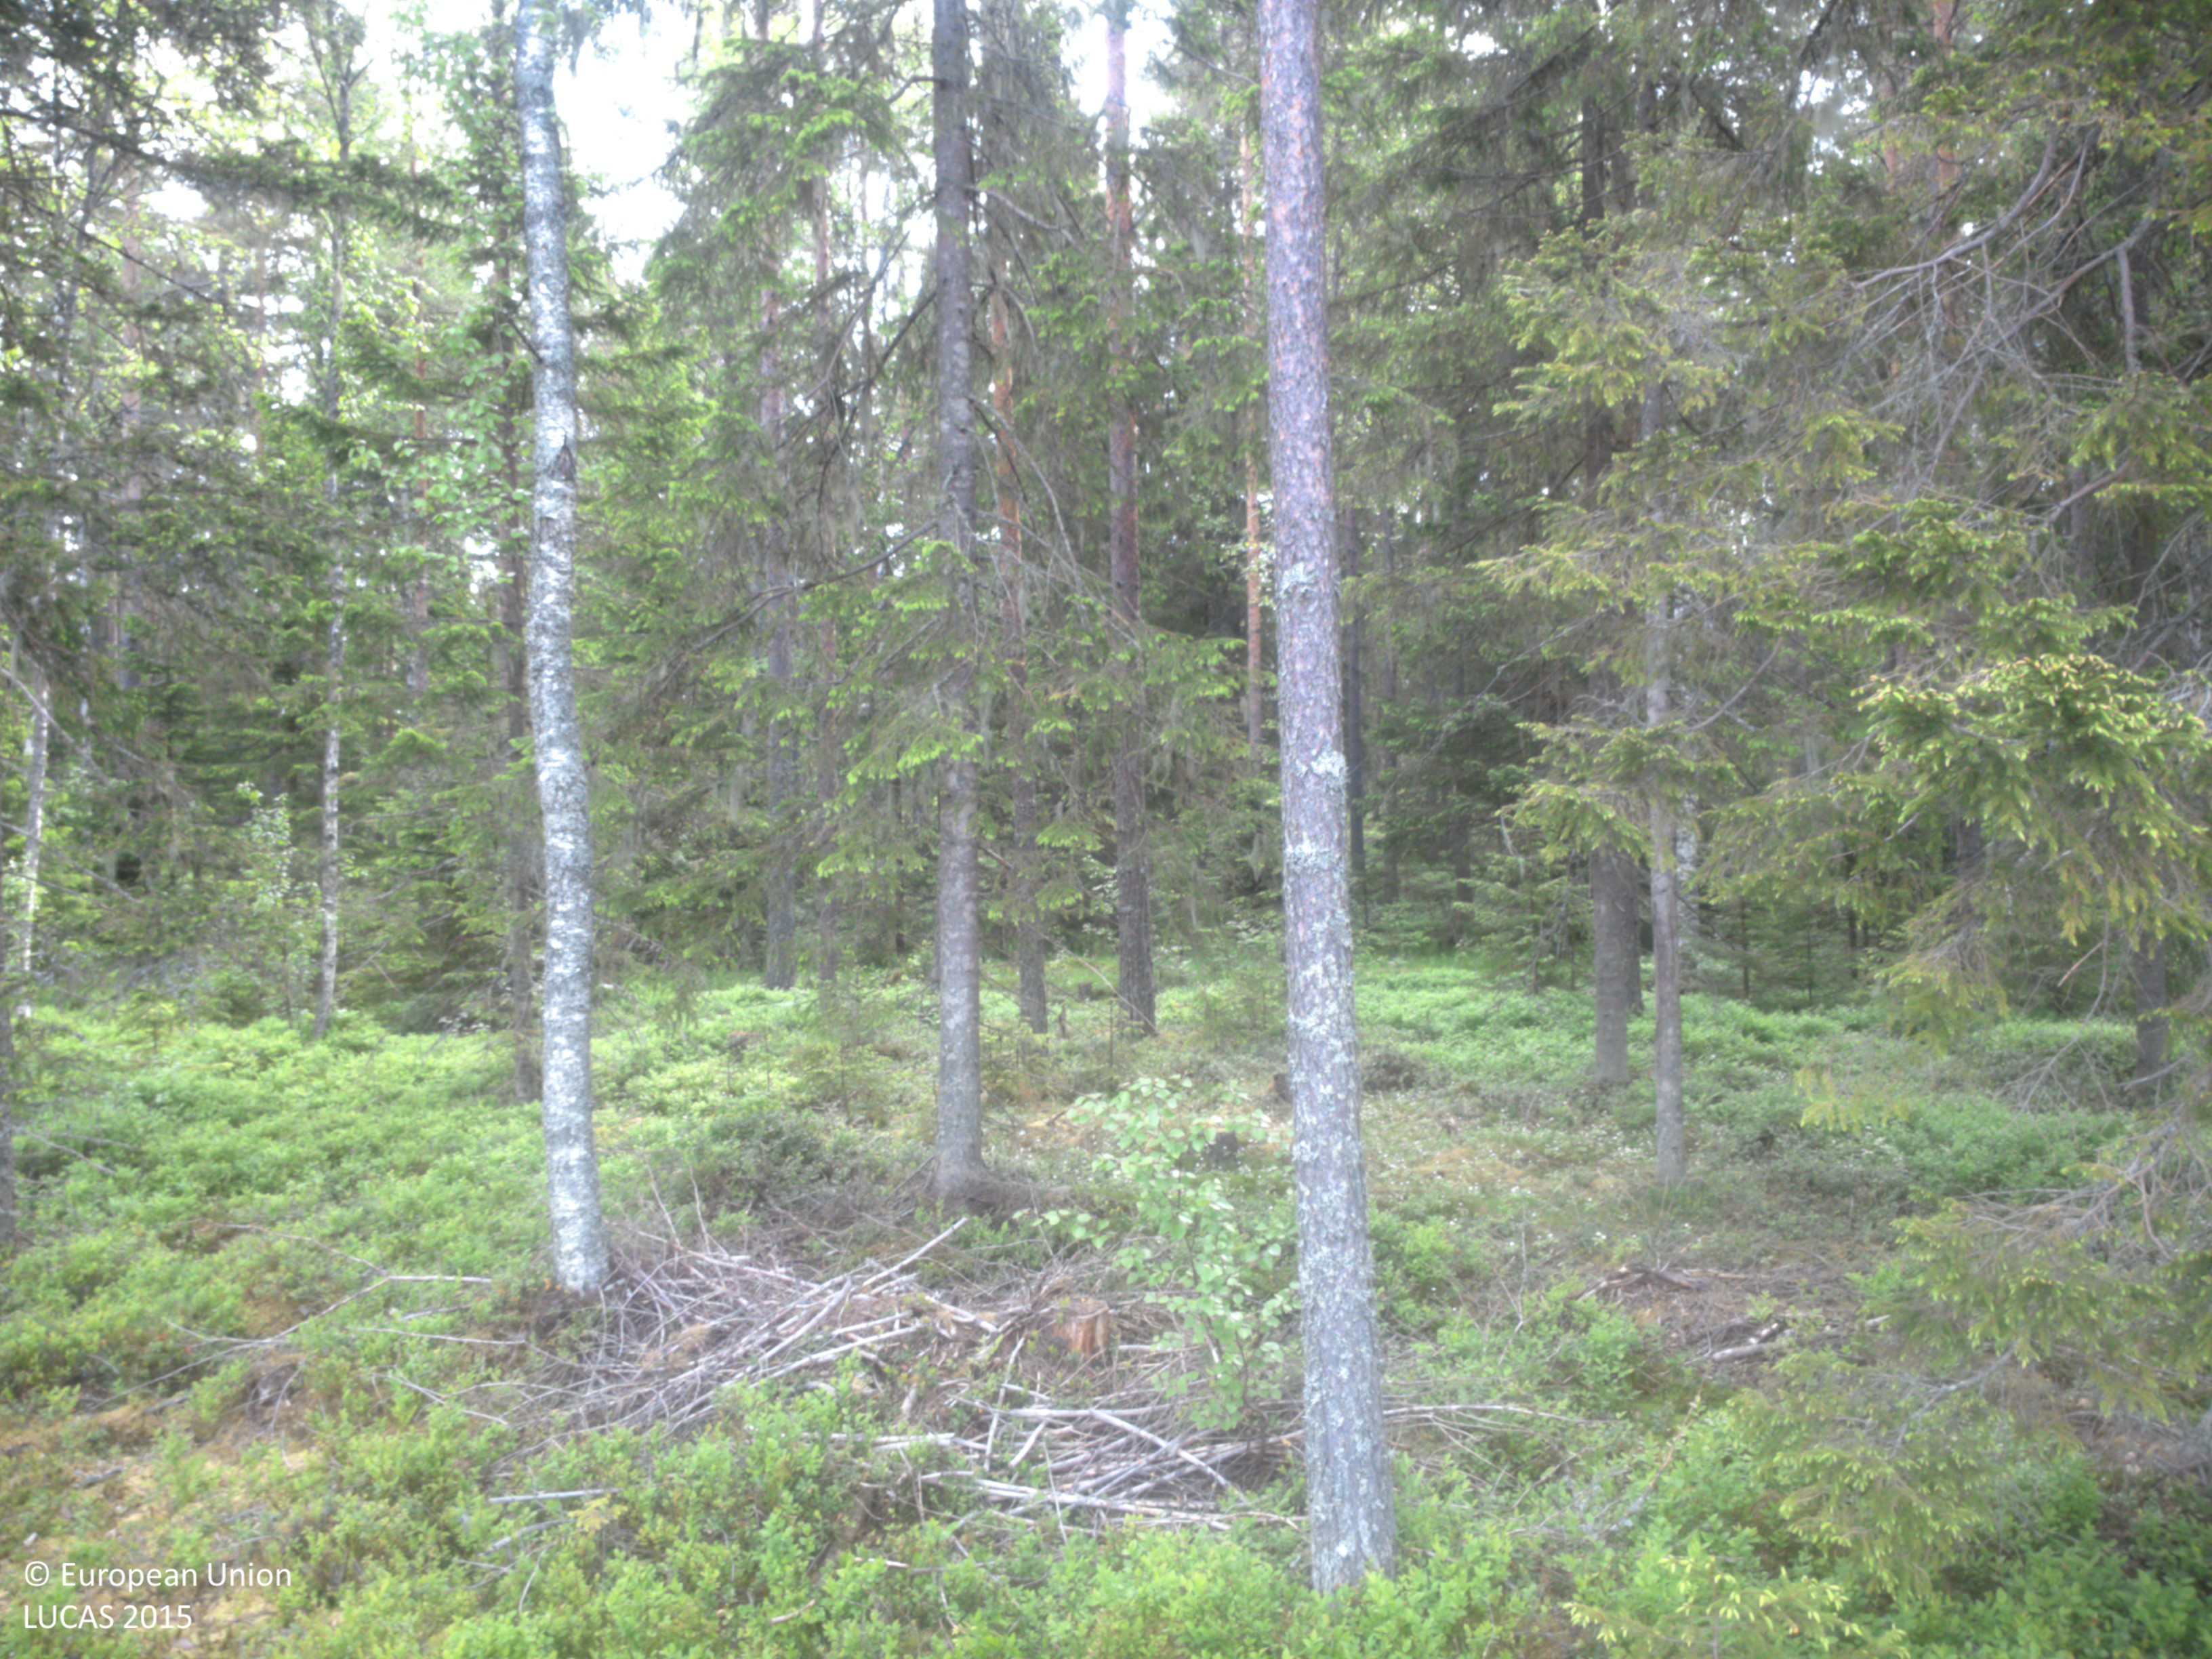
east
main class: Woodland
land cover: Pine dominated coniferous woodland
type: boreal forest
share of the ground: 25 - 50 %
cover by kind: shrubs 50 %, coniferous forest trees 40 %, herbaceous plants 10 %
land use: Forestry
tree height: > 5 m
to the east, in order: Pine dominated coniferous woodland; Spruce dominated coniferous woodland; Ditches and canals; Pine dominated mixed woodland; Tracks; Pine dominated mixed woodland; Tracks; Spruce dominated mixed woodland; Grassland with sparse tree/shrub cover; Ditches and canals; Spruce dominated coniferous woodland; Grassland with sparse tree/shrub cover; Ditches and canals; Spruce dominated mixed woodland
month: June
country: SE
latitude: 63.5671
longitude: 19.7869
